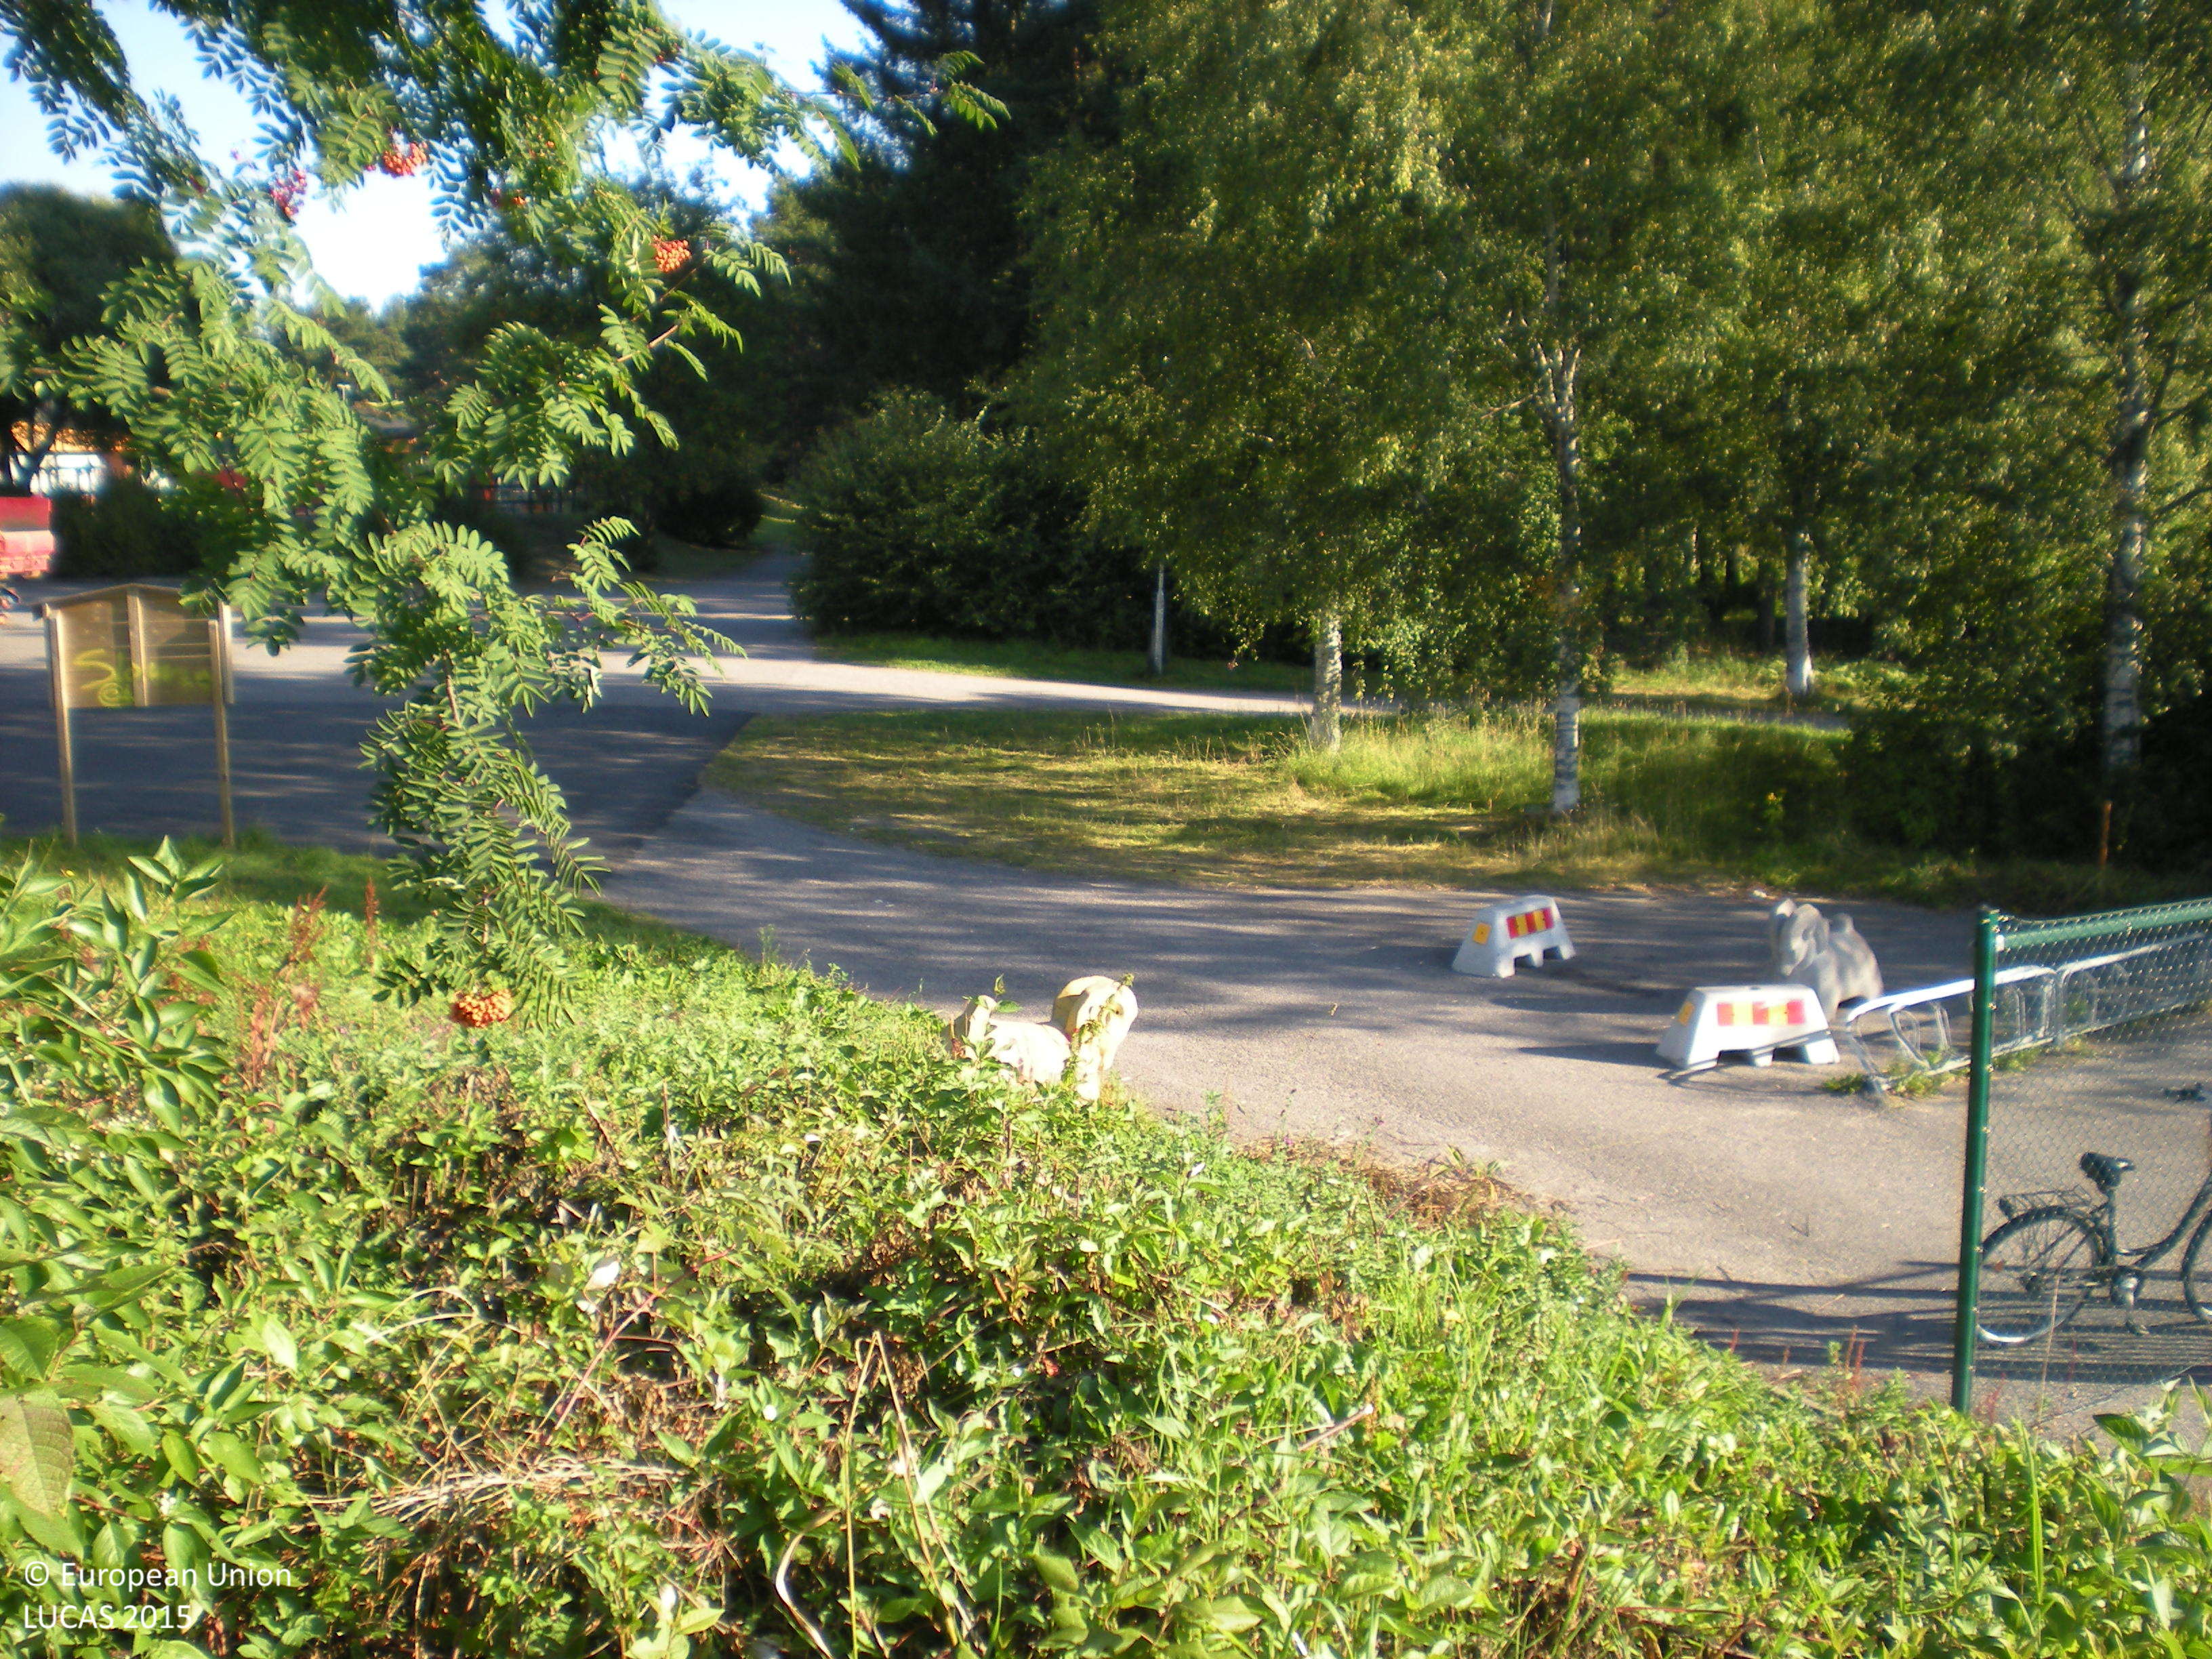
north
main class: Shrubland
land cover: Shrubland with sparse tree cover
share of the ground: > 75 %
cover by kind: shrubs 95 %, broadleaved forest trees 5 %
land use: Amenities, museums, leisure
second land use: Sport
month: August
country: SE
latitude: 60.6509
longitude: 17.1408
